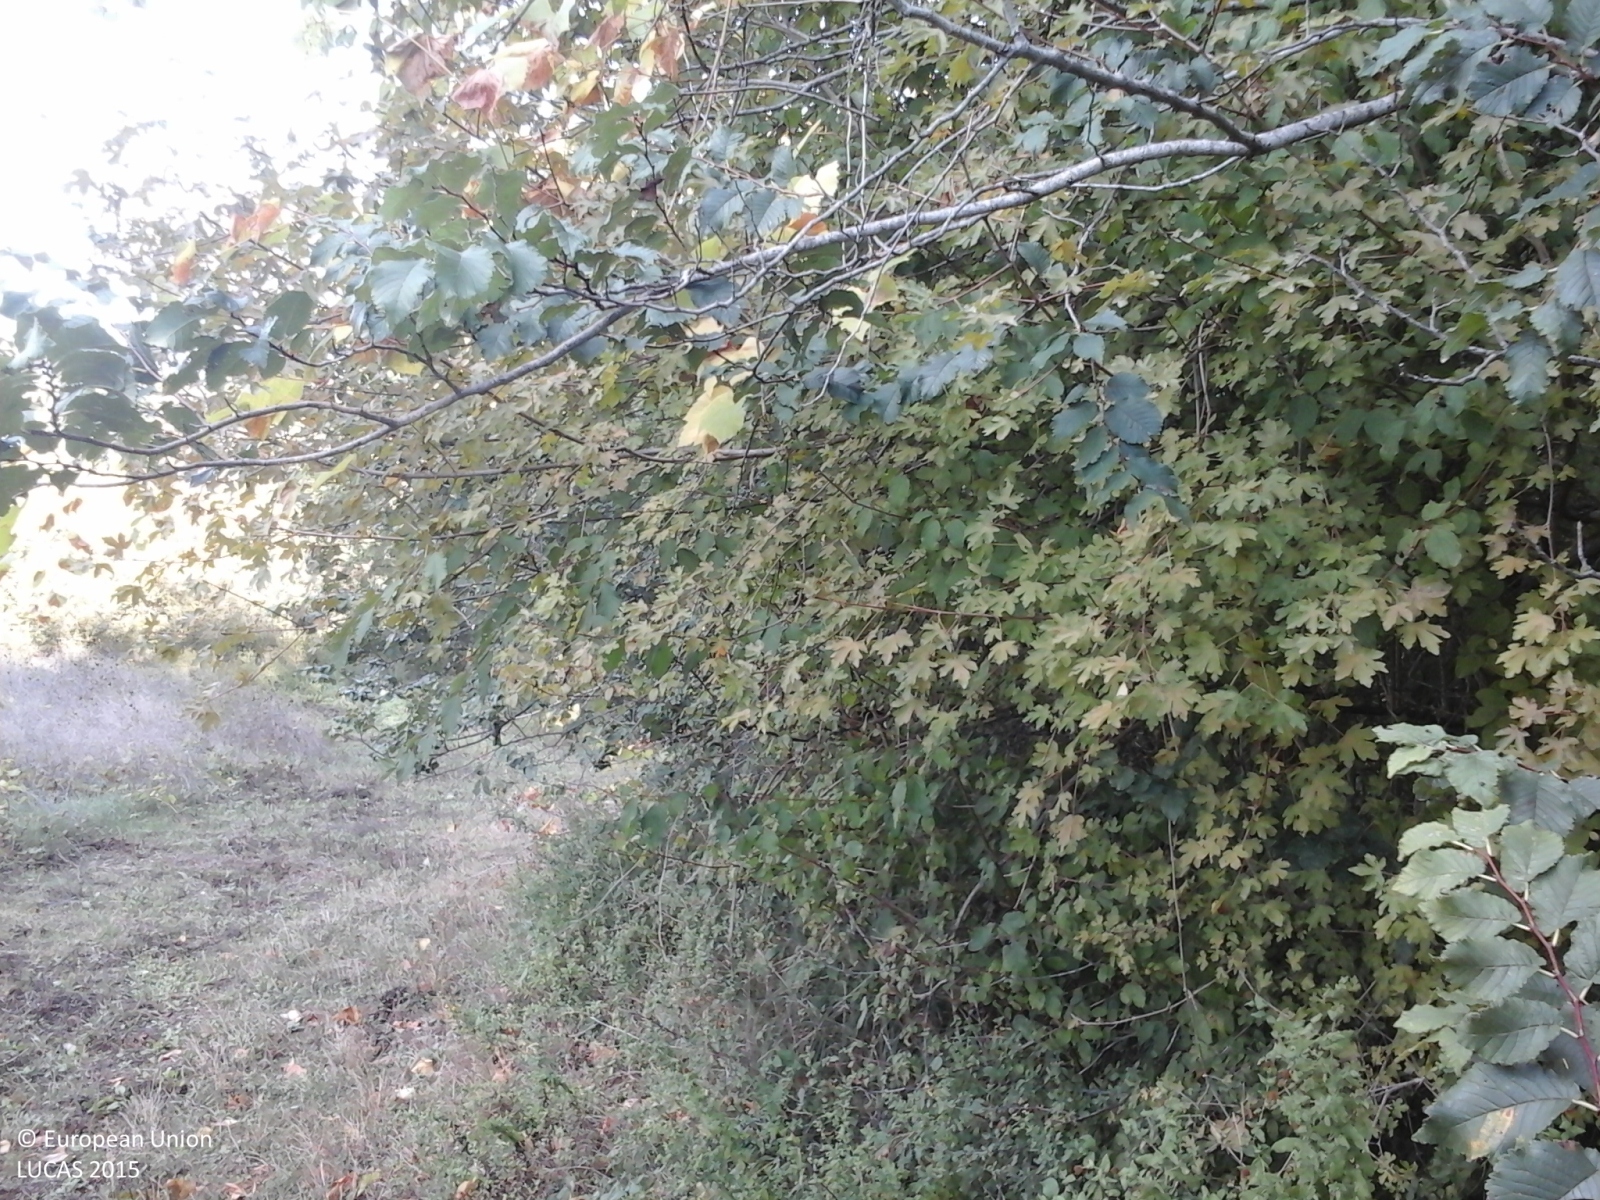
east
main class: Woodland
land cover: Broadleaved woodland
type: mesophytic deciduous forest
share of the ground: > 75 %
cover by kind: broadleaved forest trees 100 %
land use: Forestry
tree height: > 5 m
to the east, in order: Broadleaved woodland
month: July
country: IT
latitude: 43.4982
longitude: 10.9496
